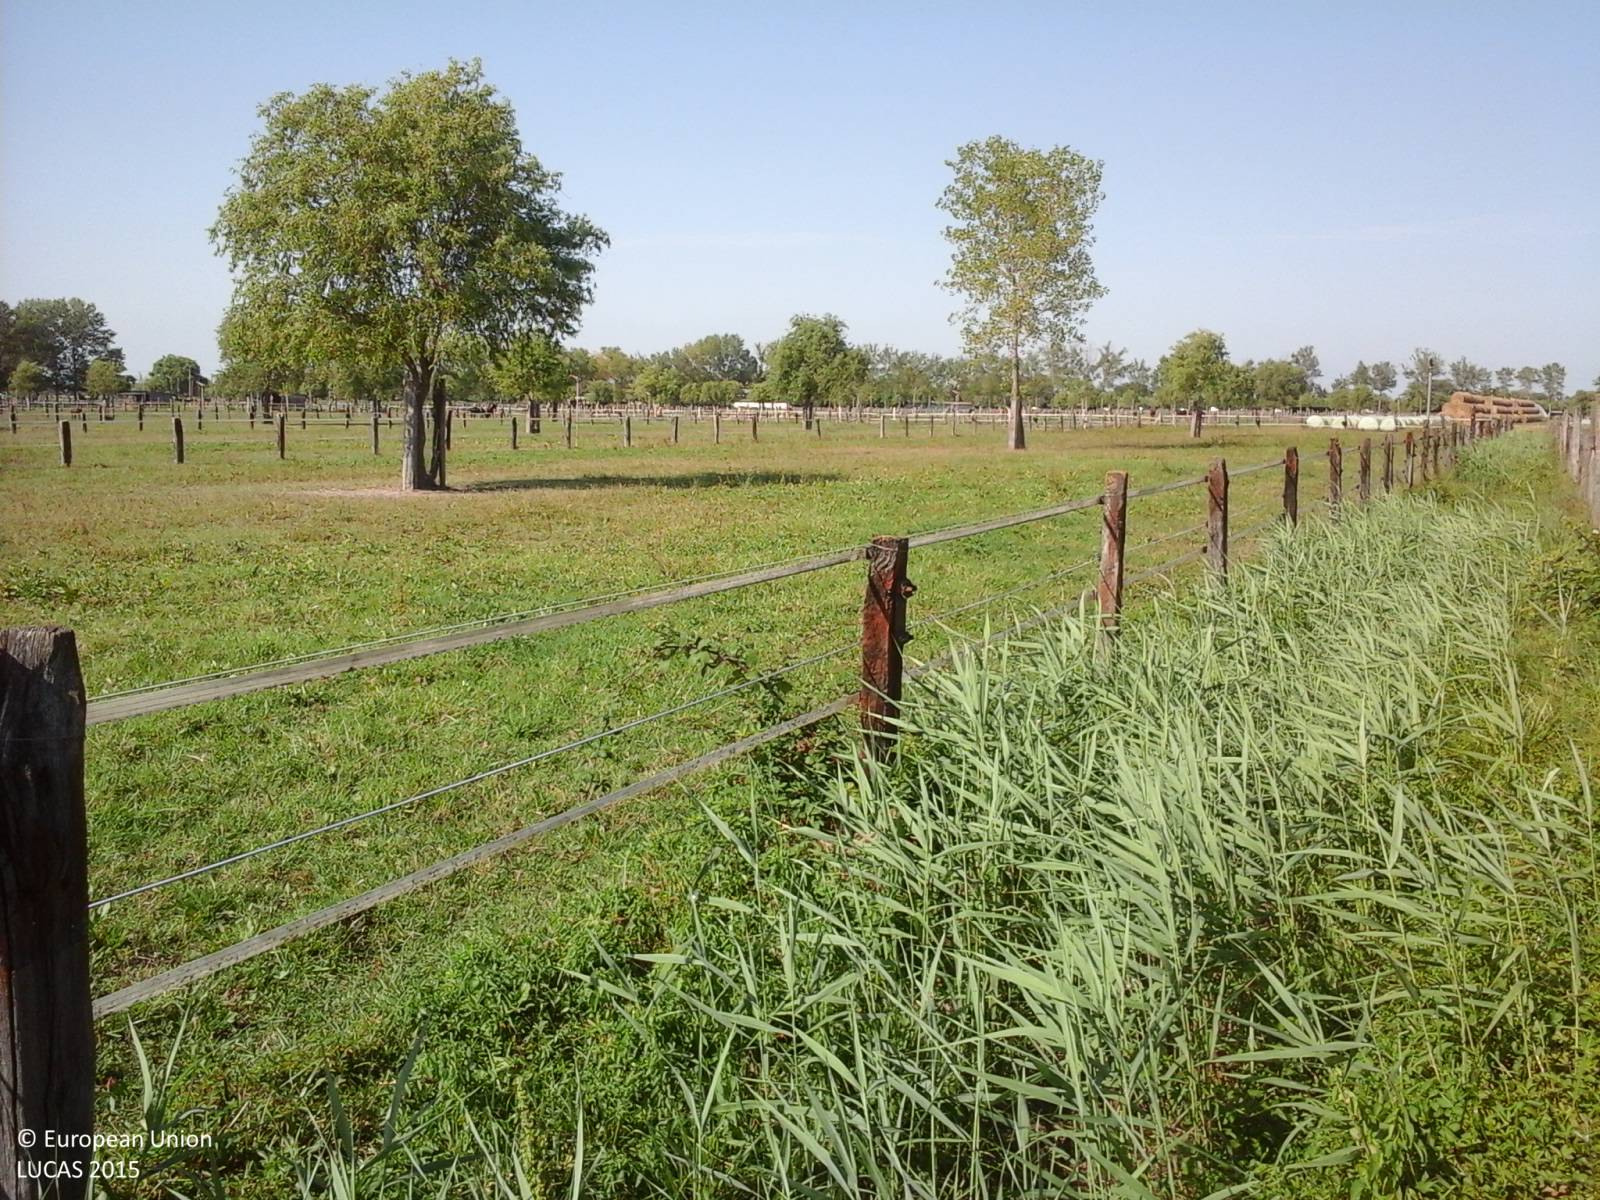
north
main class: Grassland
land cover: Grassland without tree/shrub cover
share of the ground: > 75 %
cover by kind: herbaceous plants 100 %
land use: Agriculture (excluding fallow land and kitchen gardens)
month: July
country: IT
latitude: 45.6771
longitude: 13.0386
